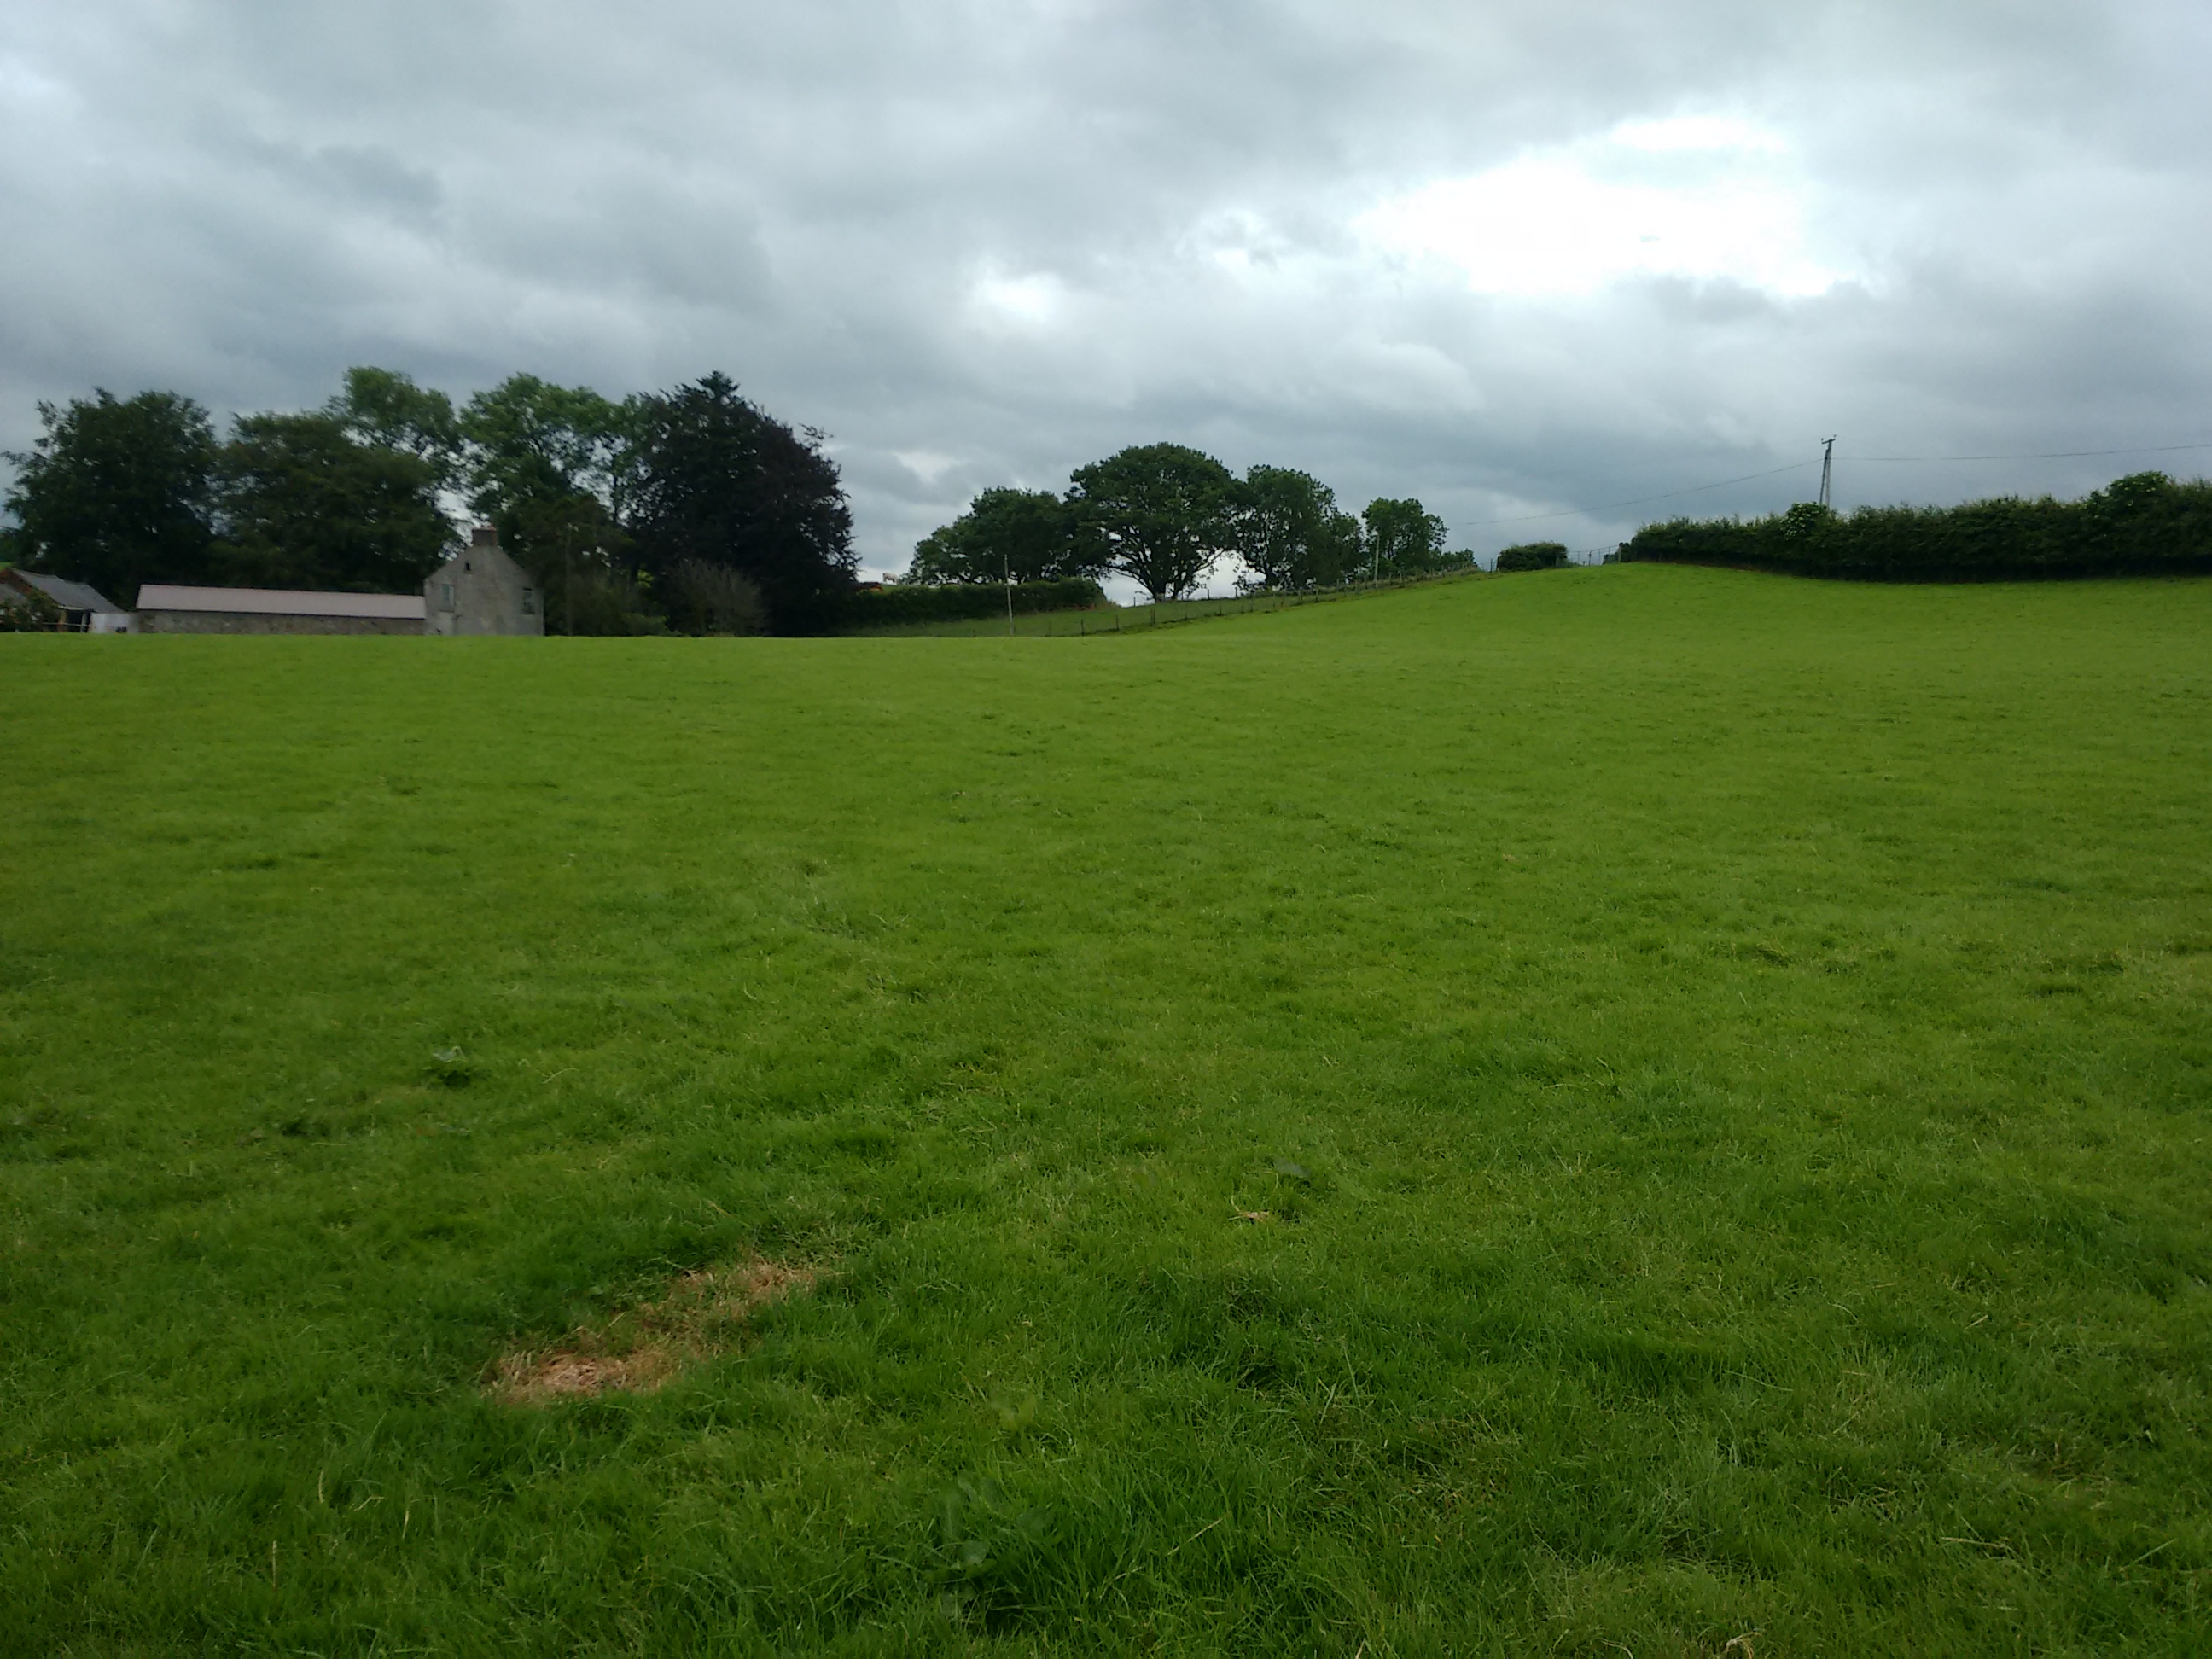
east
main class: Grassland
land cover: Grassland without tree/shrub cover
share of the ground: > 75 %
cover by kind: herbaceous plants 100 %
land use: Agriculture (excluding fallow land and kitchen gardens)
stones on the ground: 10 - 25 %
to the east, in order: Grassland without tree/shrub cover; Fences; Grassland without tree/shrub cover; Electric lines; Grassland without tree/shrub cover; Fences; Paved roads, cycling and walking lanes; Managed hedges; Grassland without tree/shrub cover; Fences; Abandoned hedges; Grass margins; Paved roads, cycling and walking lanes; Grass margins; Fences; Grassland without tree/shrub cover
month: July
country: GB
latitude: 54.5952
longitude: -7.1538
